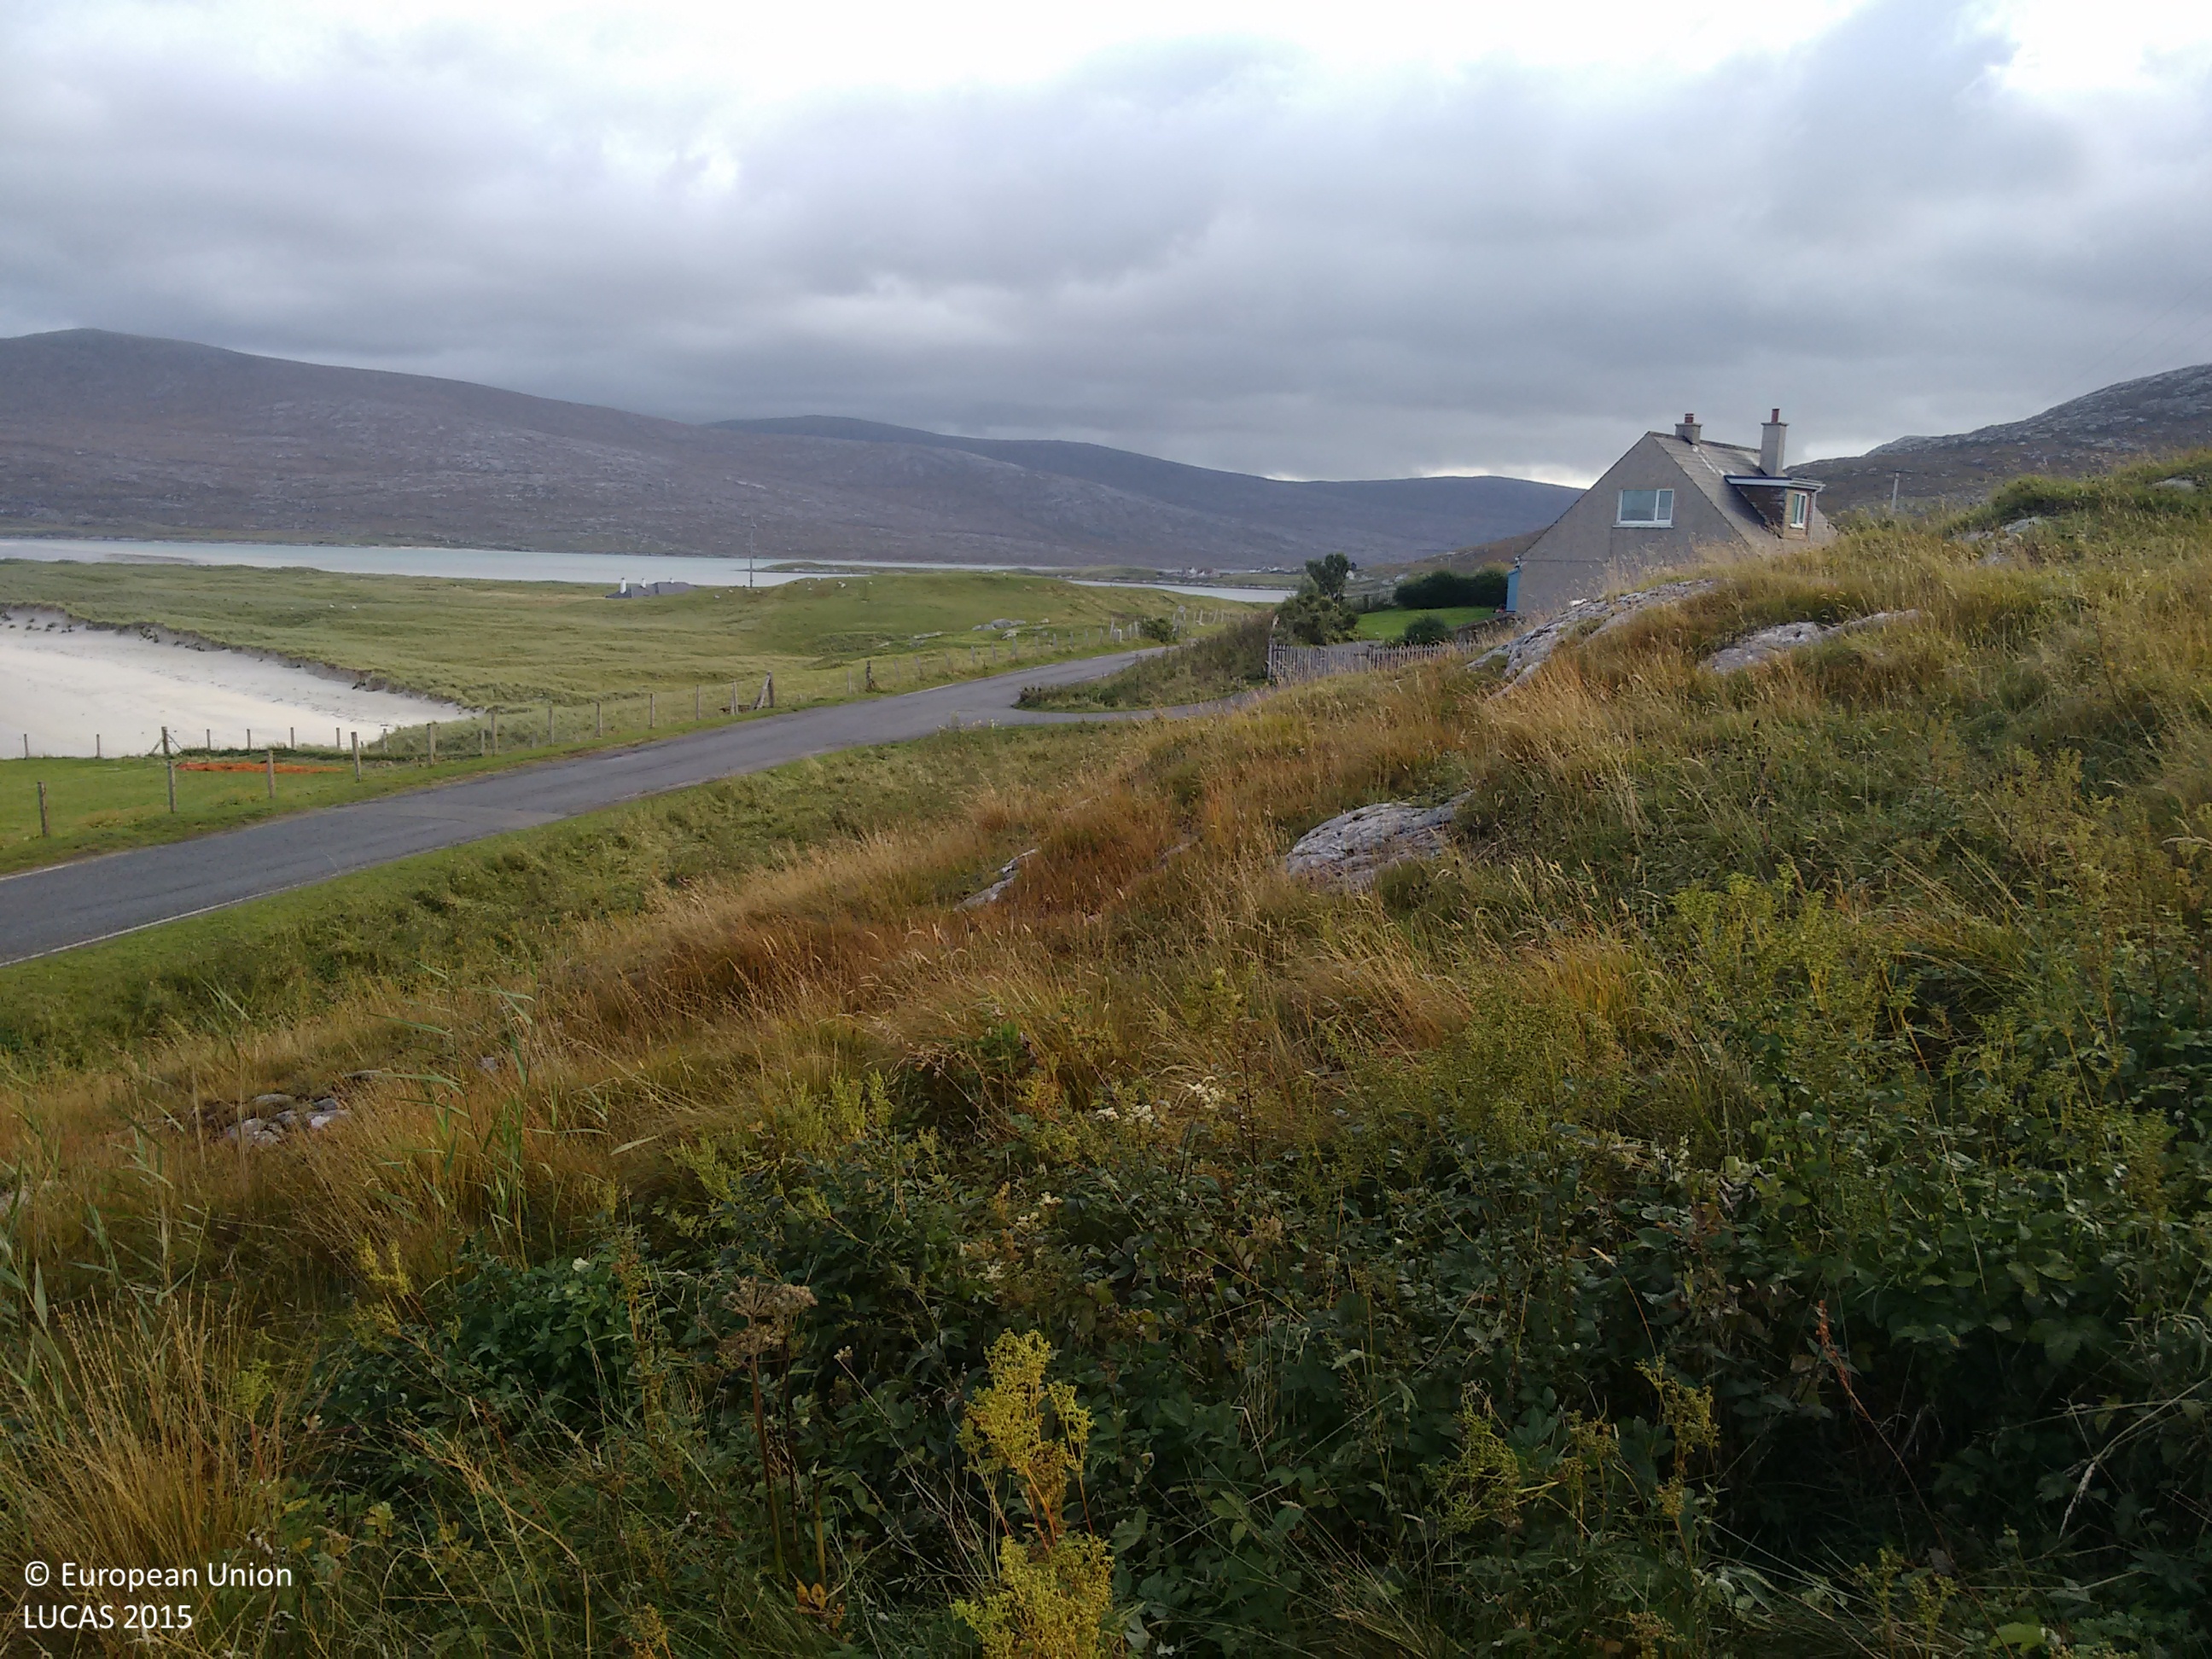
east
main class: Grassland
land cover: Grassland without tree/shrub cover
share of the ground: > 75 %
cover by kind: herbaceous plants 95 %
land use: Semi-natural and natural areas not in use
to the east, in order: Grassland without tree/shrub cover; Rock outcrops; Grassland without tree/shrub cover; Artificial constructions in urban areas; Spontaneously vegetated surfaces; Rock outcrops; Spontaneously vegetated surfaces; Fences; Grassland without tree/shrub cover; Rock outcrops; Grassland without tree/shrub cover; Fences; Grassland without tree/shrub cover; Artificial constructions in urban areas; Grass margins; Paved roads, cycling and walking lanes; Grass margins; Fences; Grassland without tree/shrub cover
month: October
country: GB
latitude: 57.8670
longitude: -6.9605
